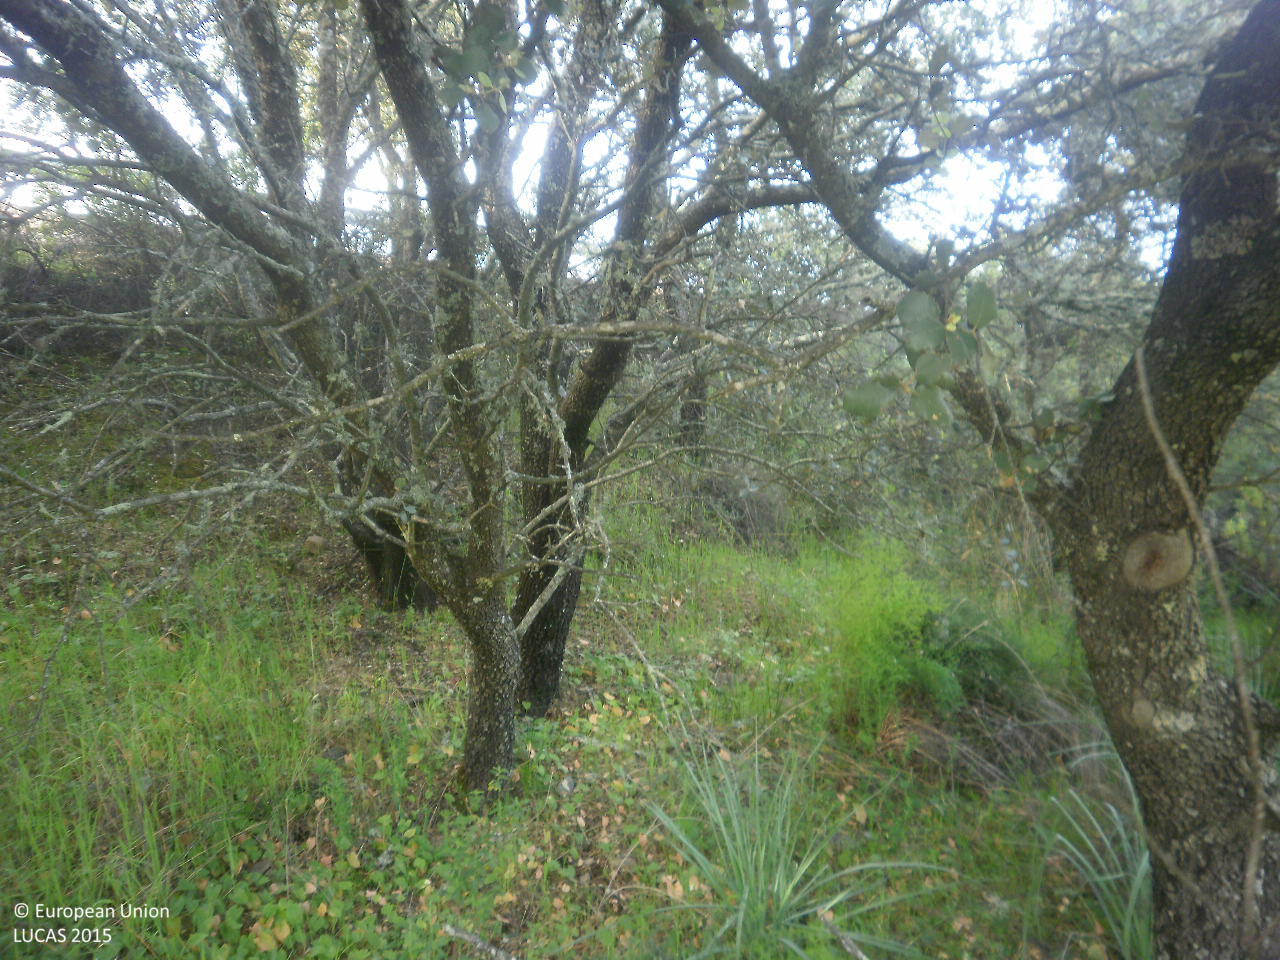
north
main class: Shrubland
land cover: Shrubland with sparse tree cover
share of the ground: 25 - 50 %
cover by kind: shrubs 50 %, consolidated bare surface 35 %, herbaceous plants 10 %, broadleaved forest trees 5 %
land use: Semi-natural and natural areas not in use
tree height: > 5 m
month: April
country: ES
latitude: 39.1399
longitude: -5.2559
